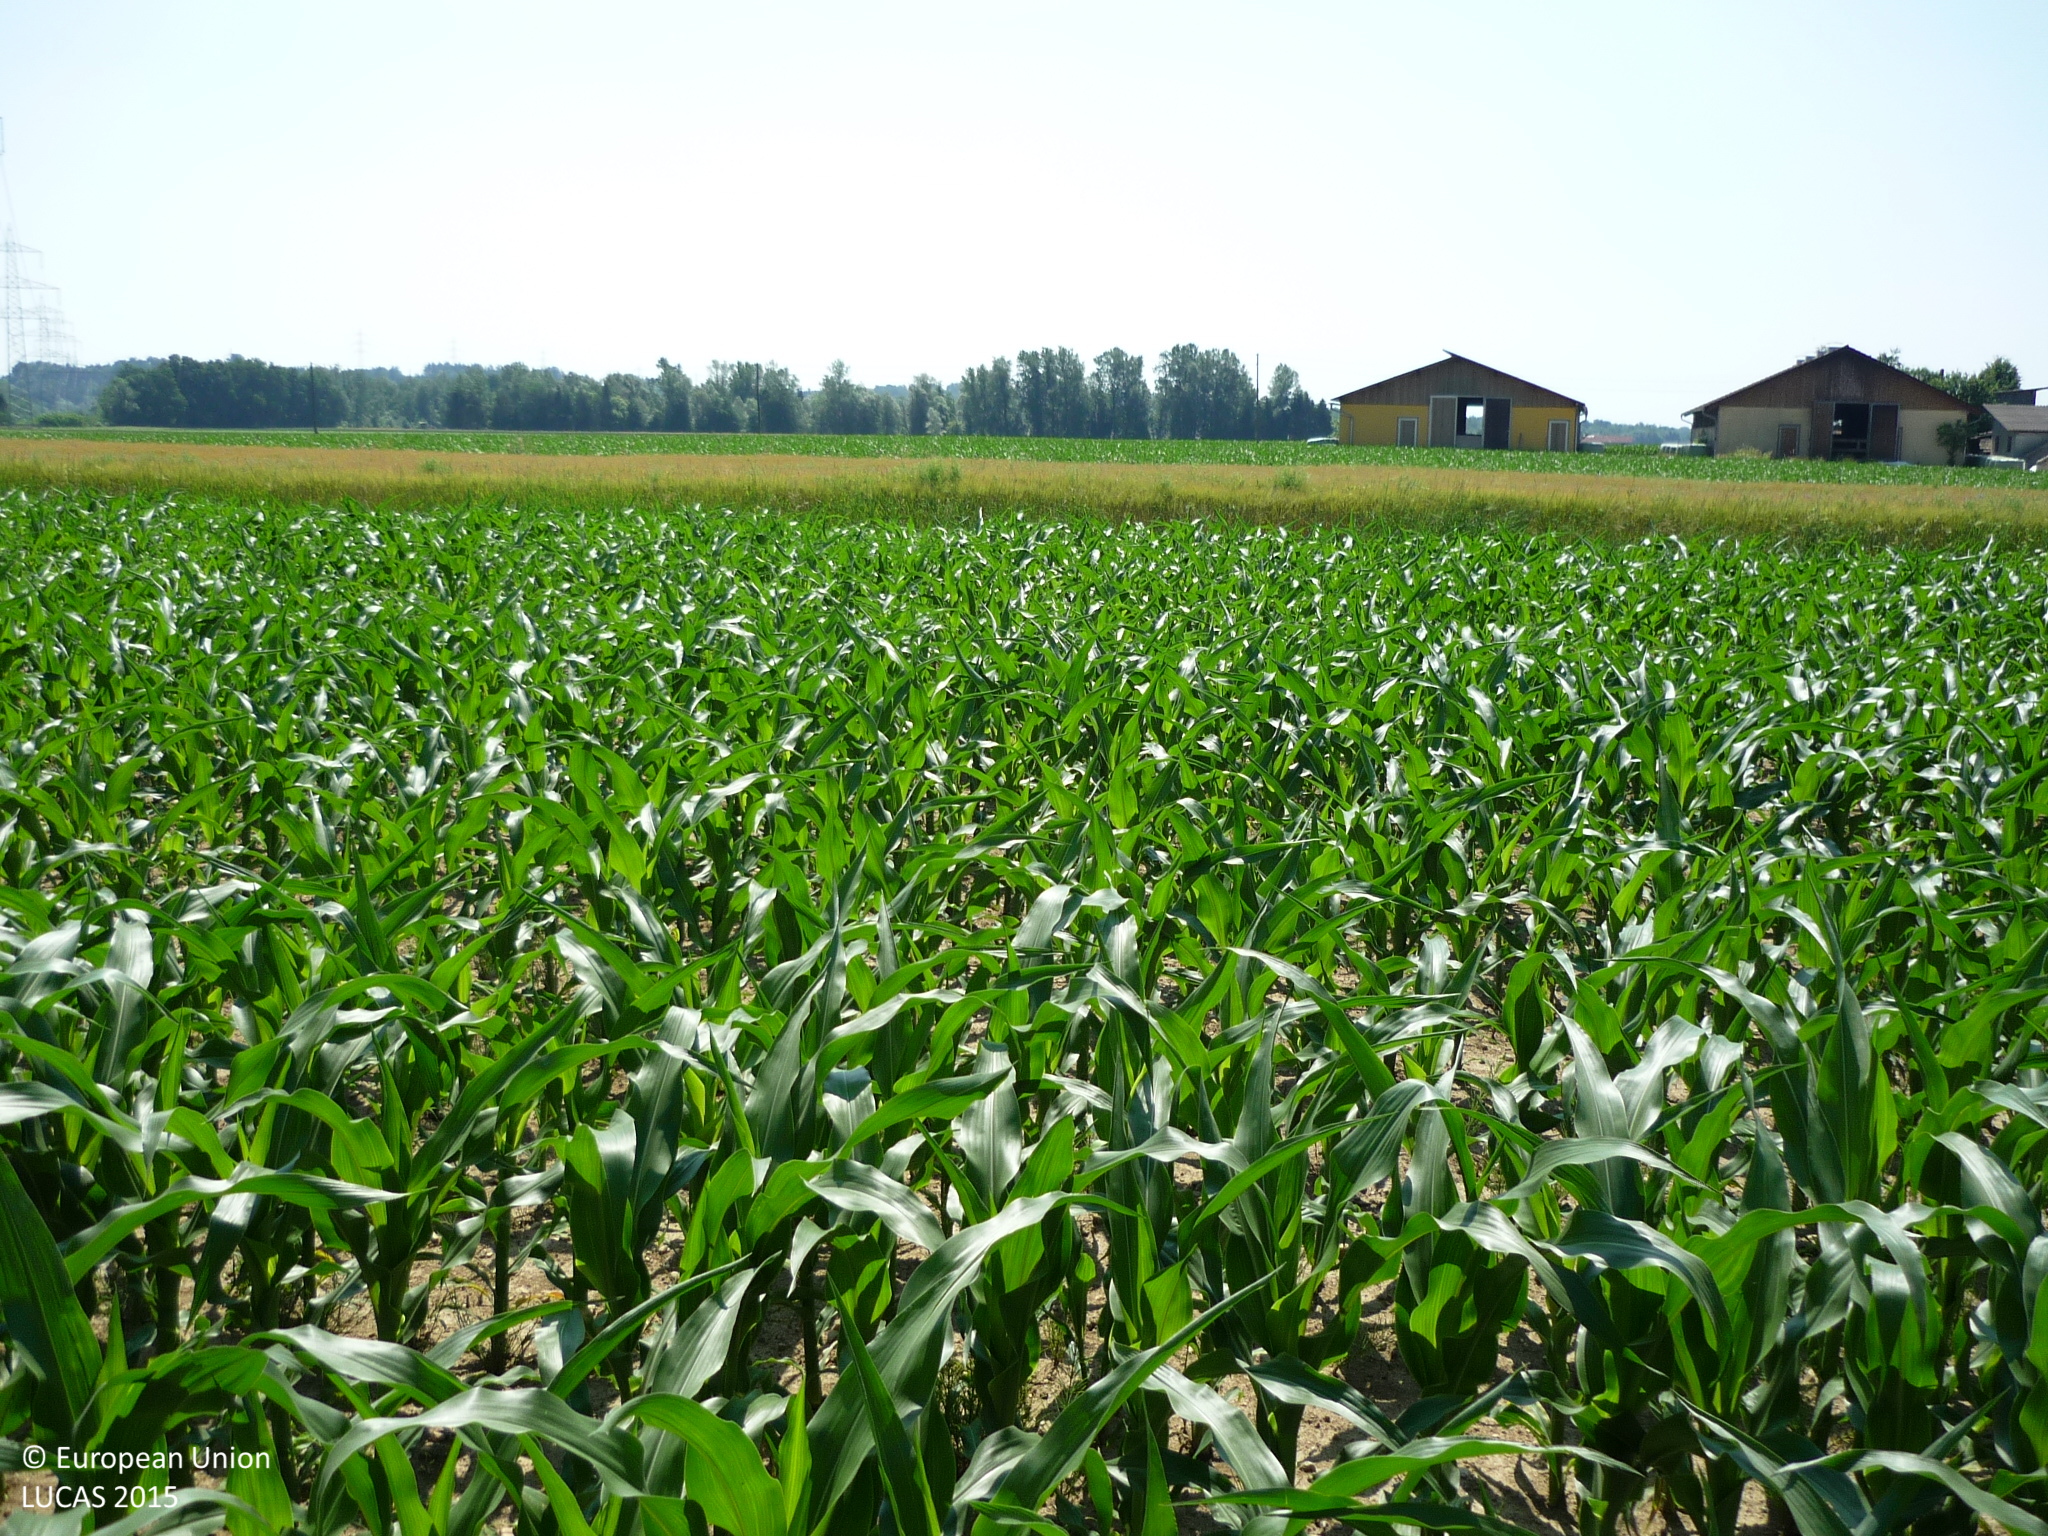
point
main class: Cropland
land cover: Maize
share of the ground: > 75 %
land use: Agriculture (excluding fallow land and kitchen gardens)
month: June
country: AT
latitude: 46.8198
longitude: 15.5701
